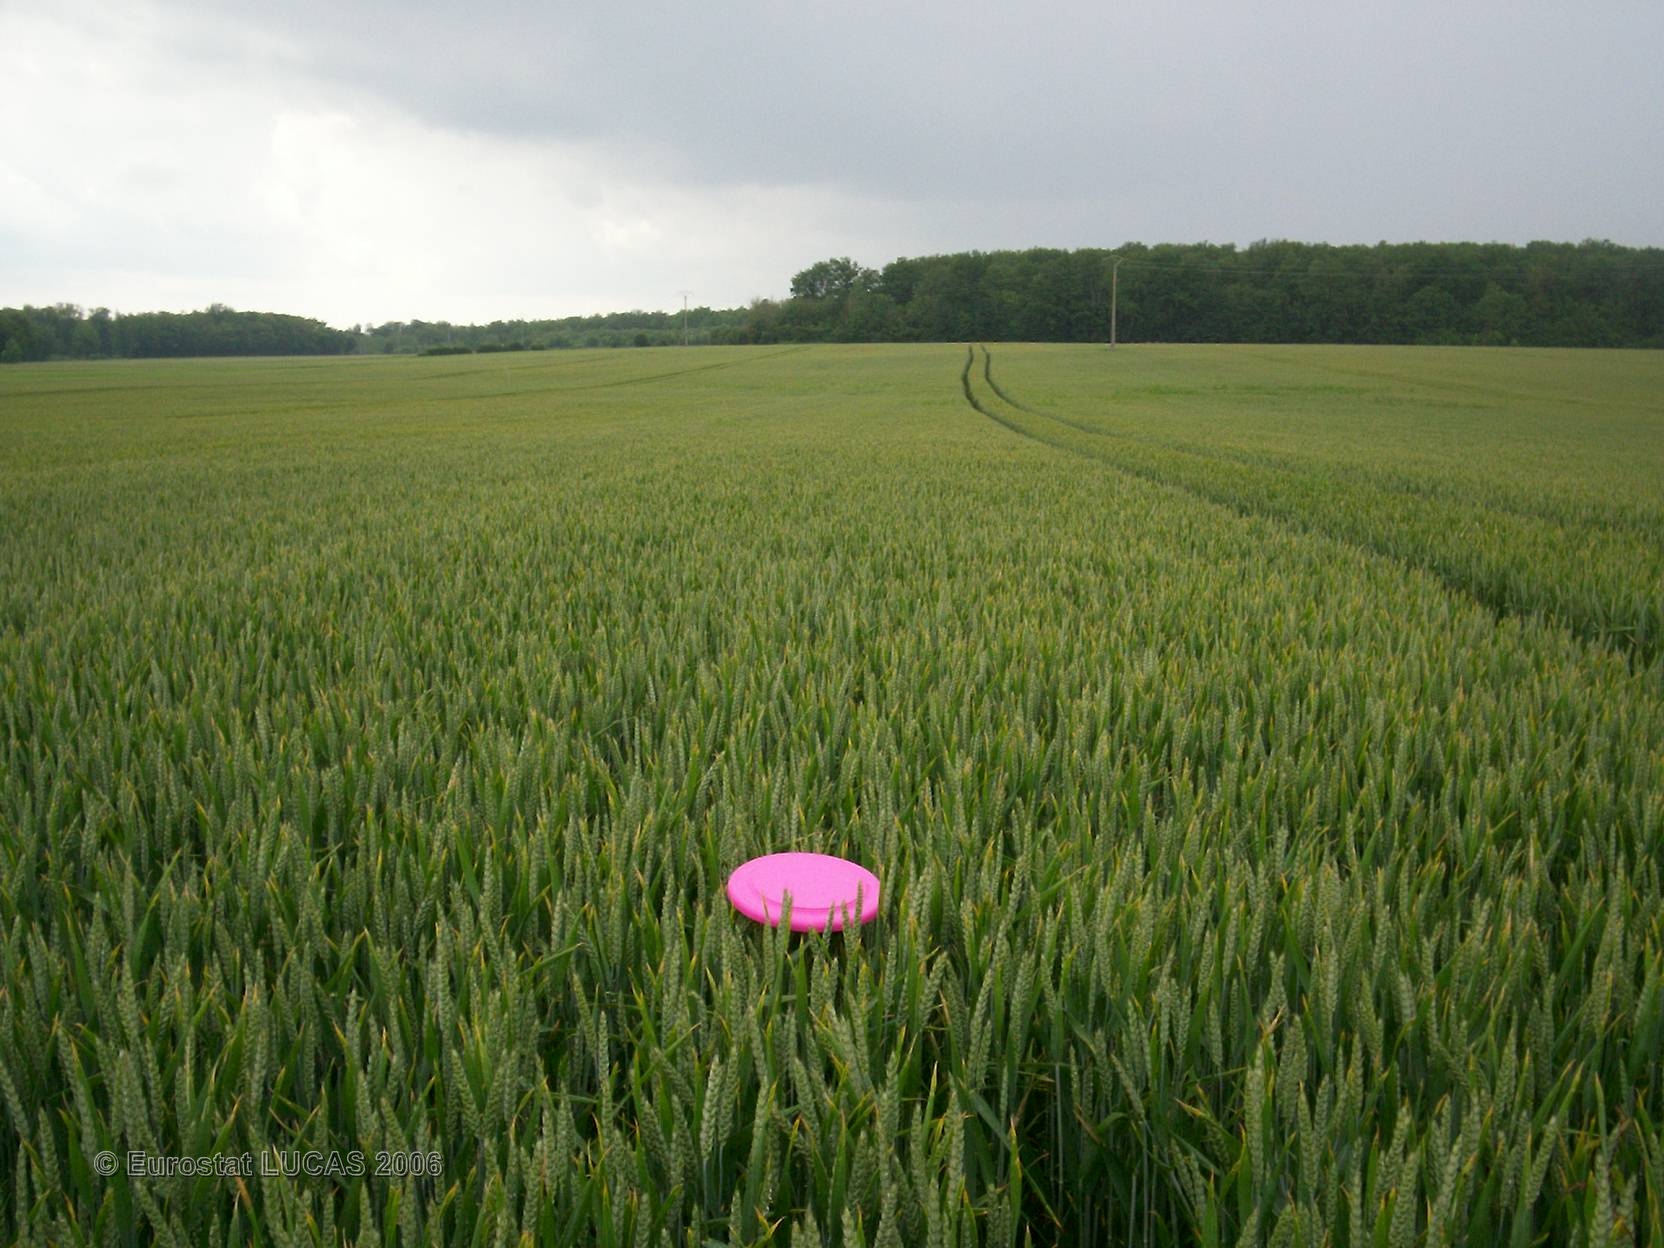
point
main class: Cropland
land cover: Common wheat
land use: Agriculture (excluding fallow land and kitchen gardens)
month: June
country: FR
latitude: 48.5623
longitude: 4.6451
